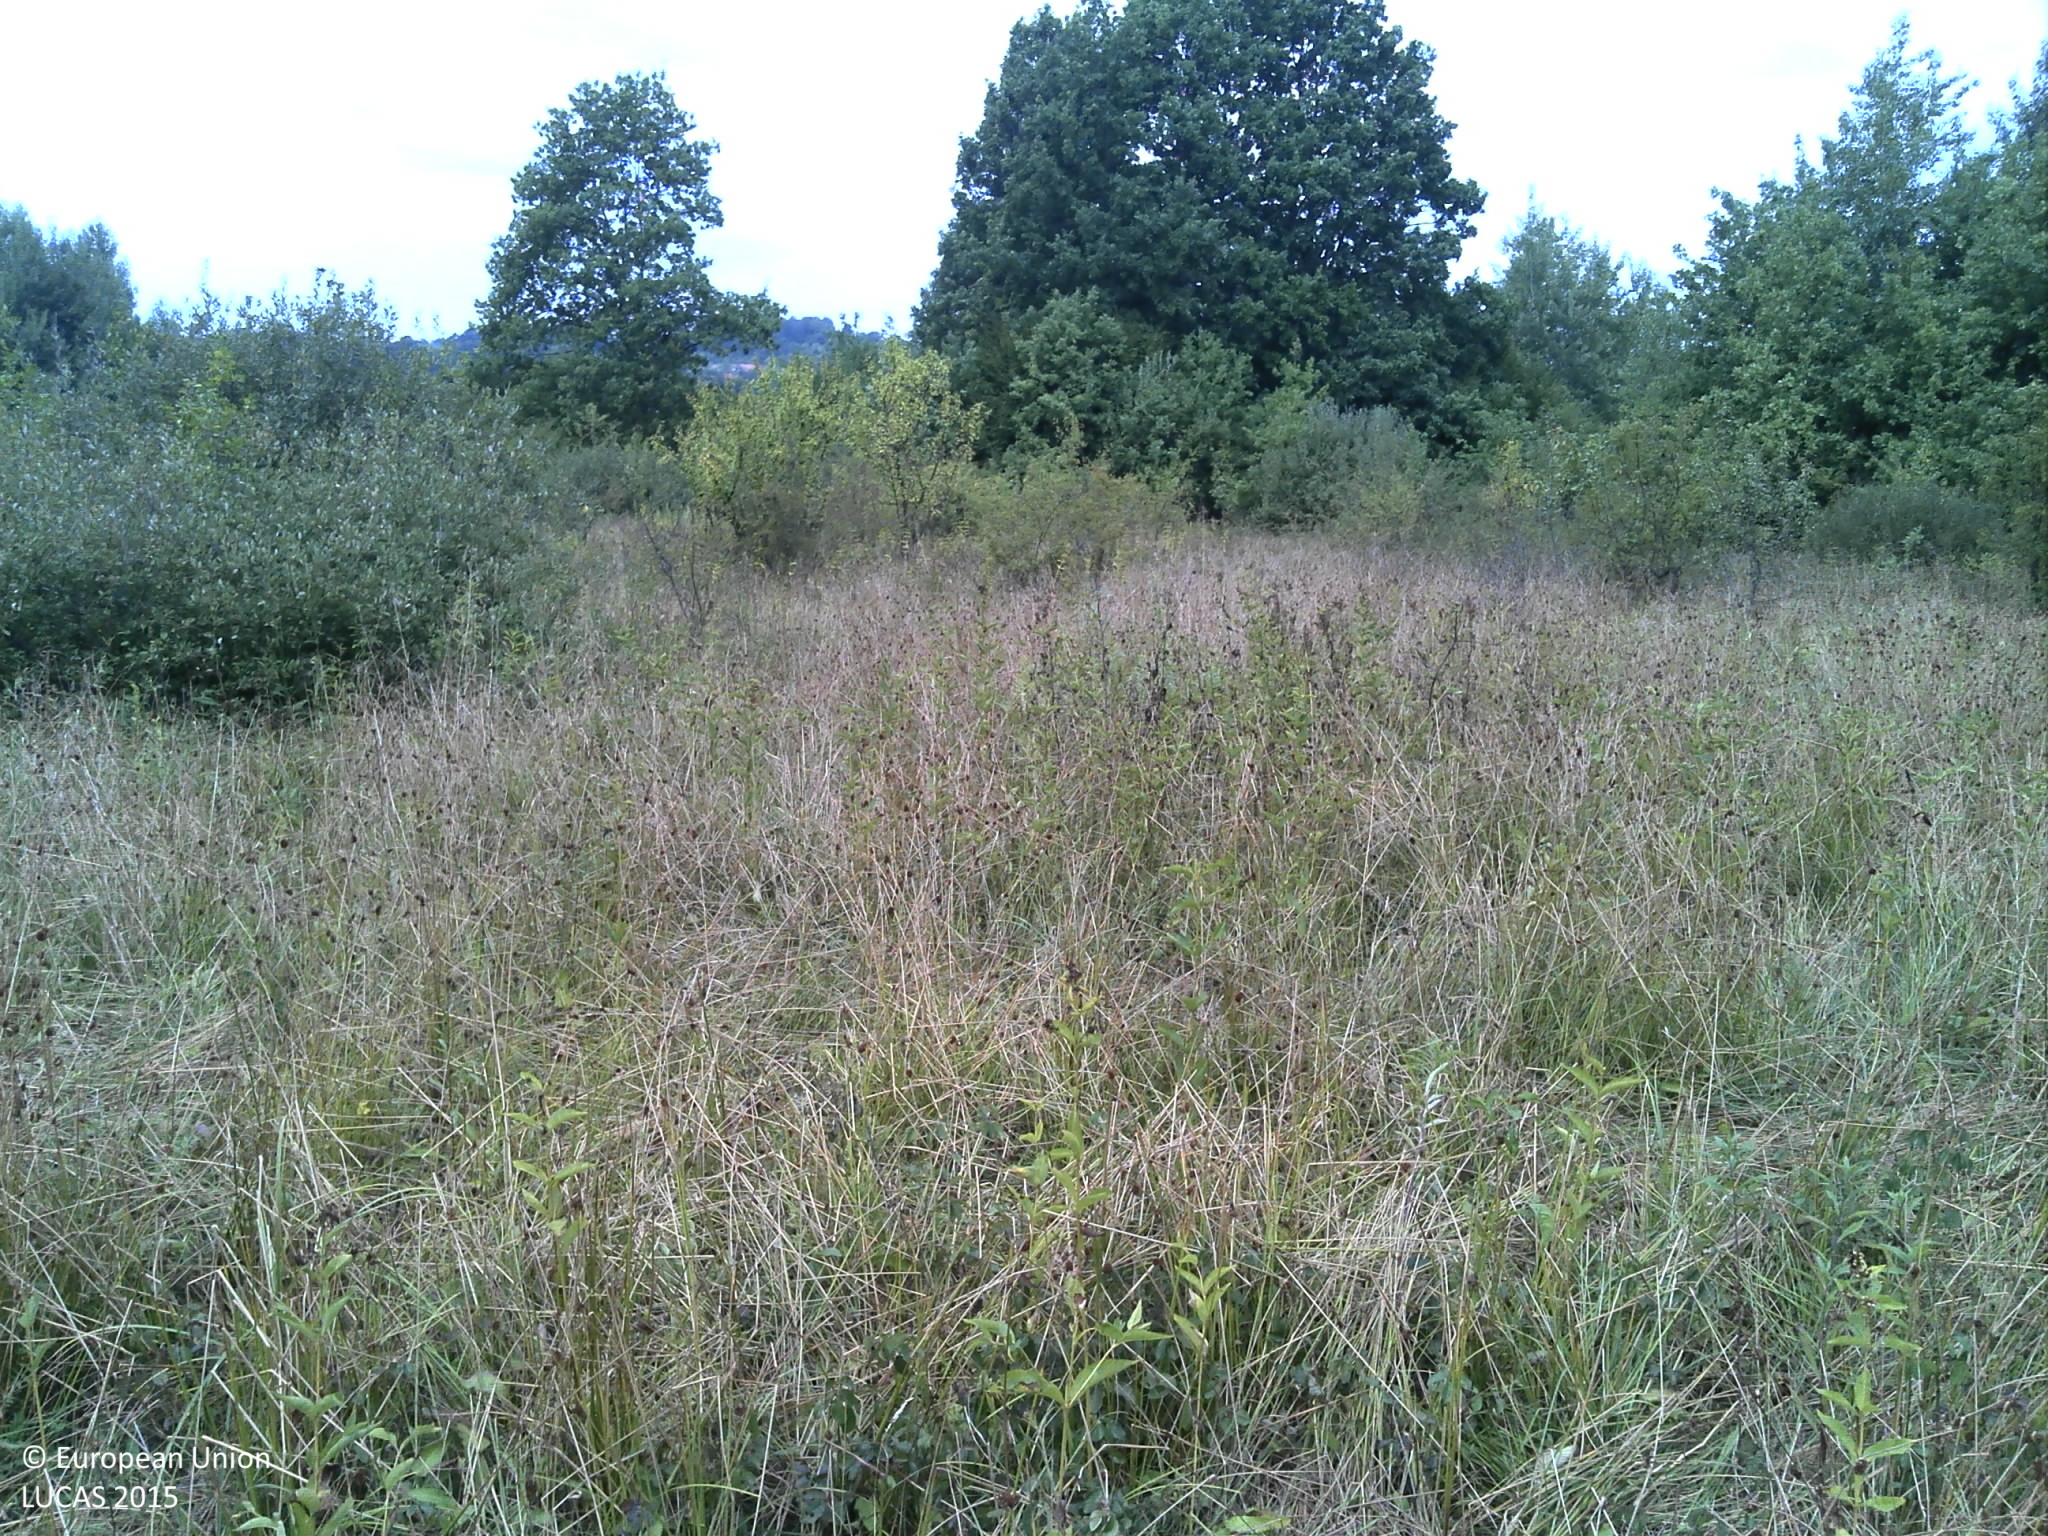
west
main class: Grassland
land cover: Spontaneously vegetated surfaces
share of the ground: > 75 %
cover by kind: herbaceous plants 100 %
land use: Fallow land
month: August
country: HR
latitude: 45.4066
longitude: 15.9890
